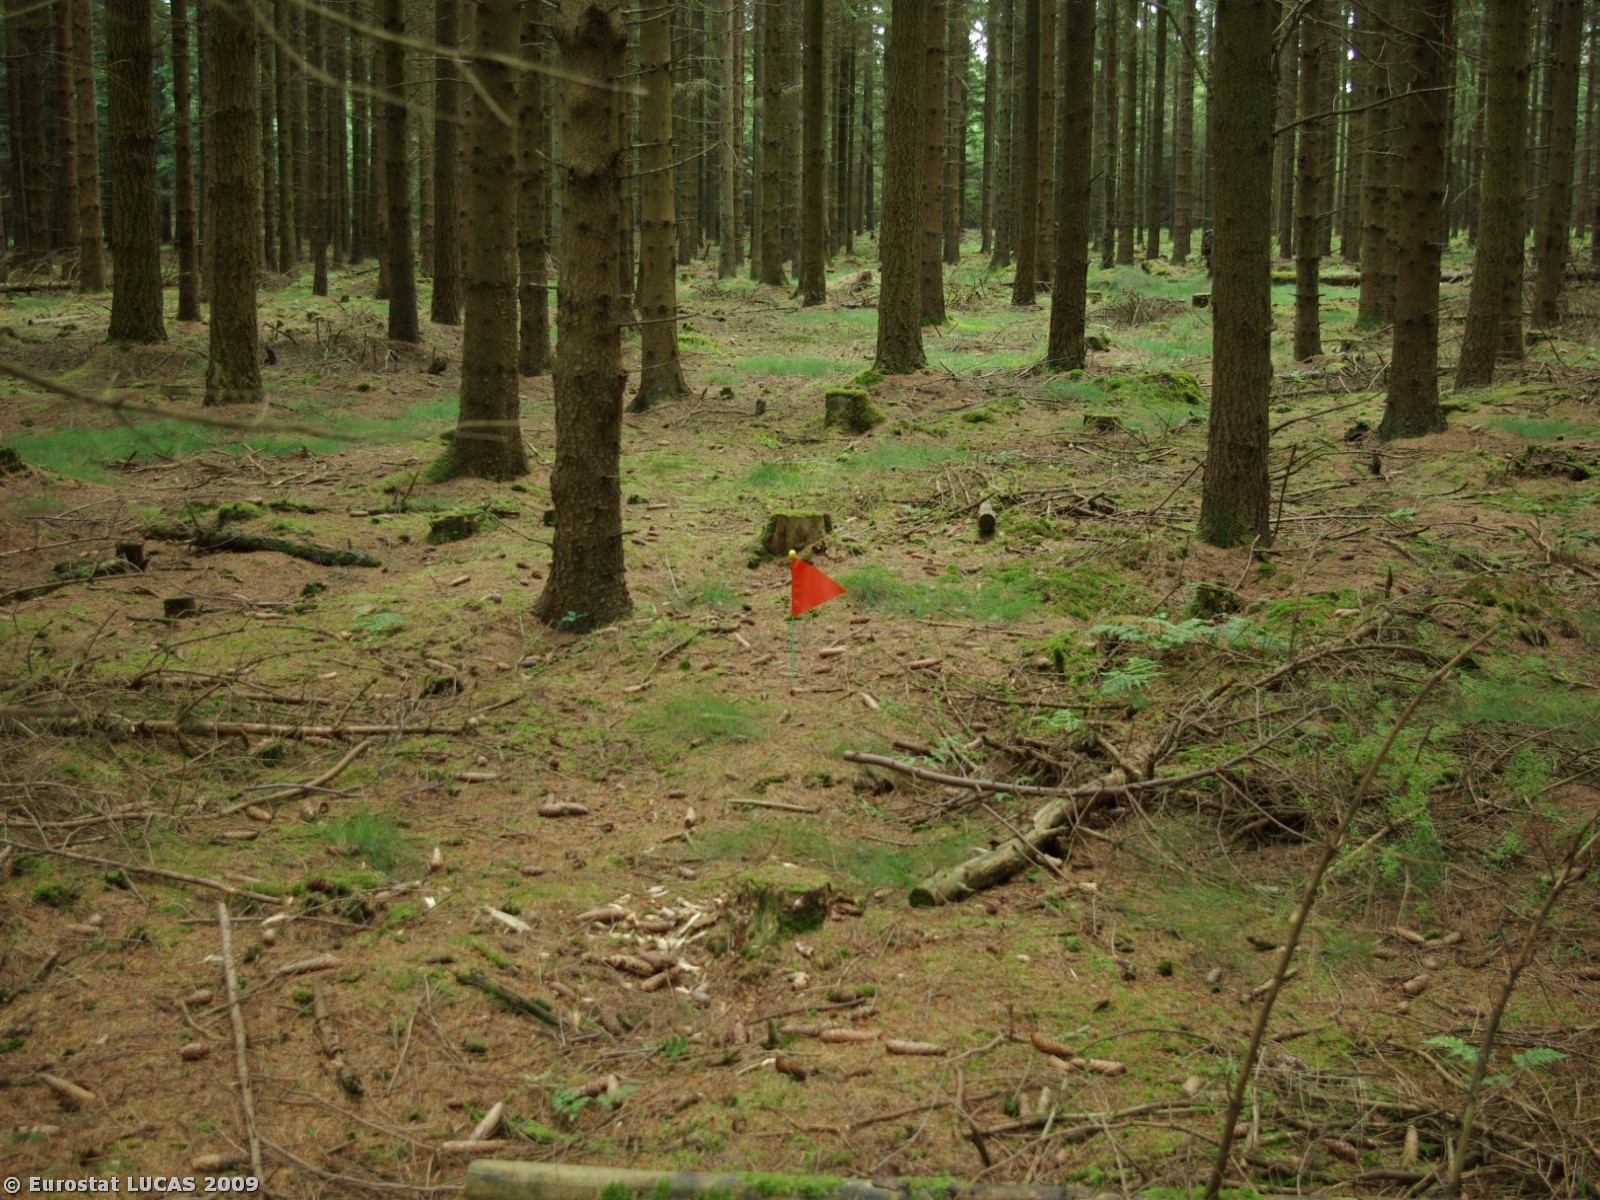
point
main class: Woodland
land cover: Coniferous woodland
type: hemiboreal forest and nemoral coniferous forest and mixed broadleaved-coniferous forest
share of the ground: > 75 %
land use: Forestry
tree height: > 5 m
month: July
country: DK
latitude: 54.8198
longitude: 9.3002
